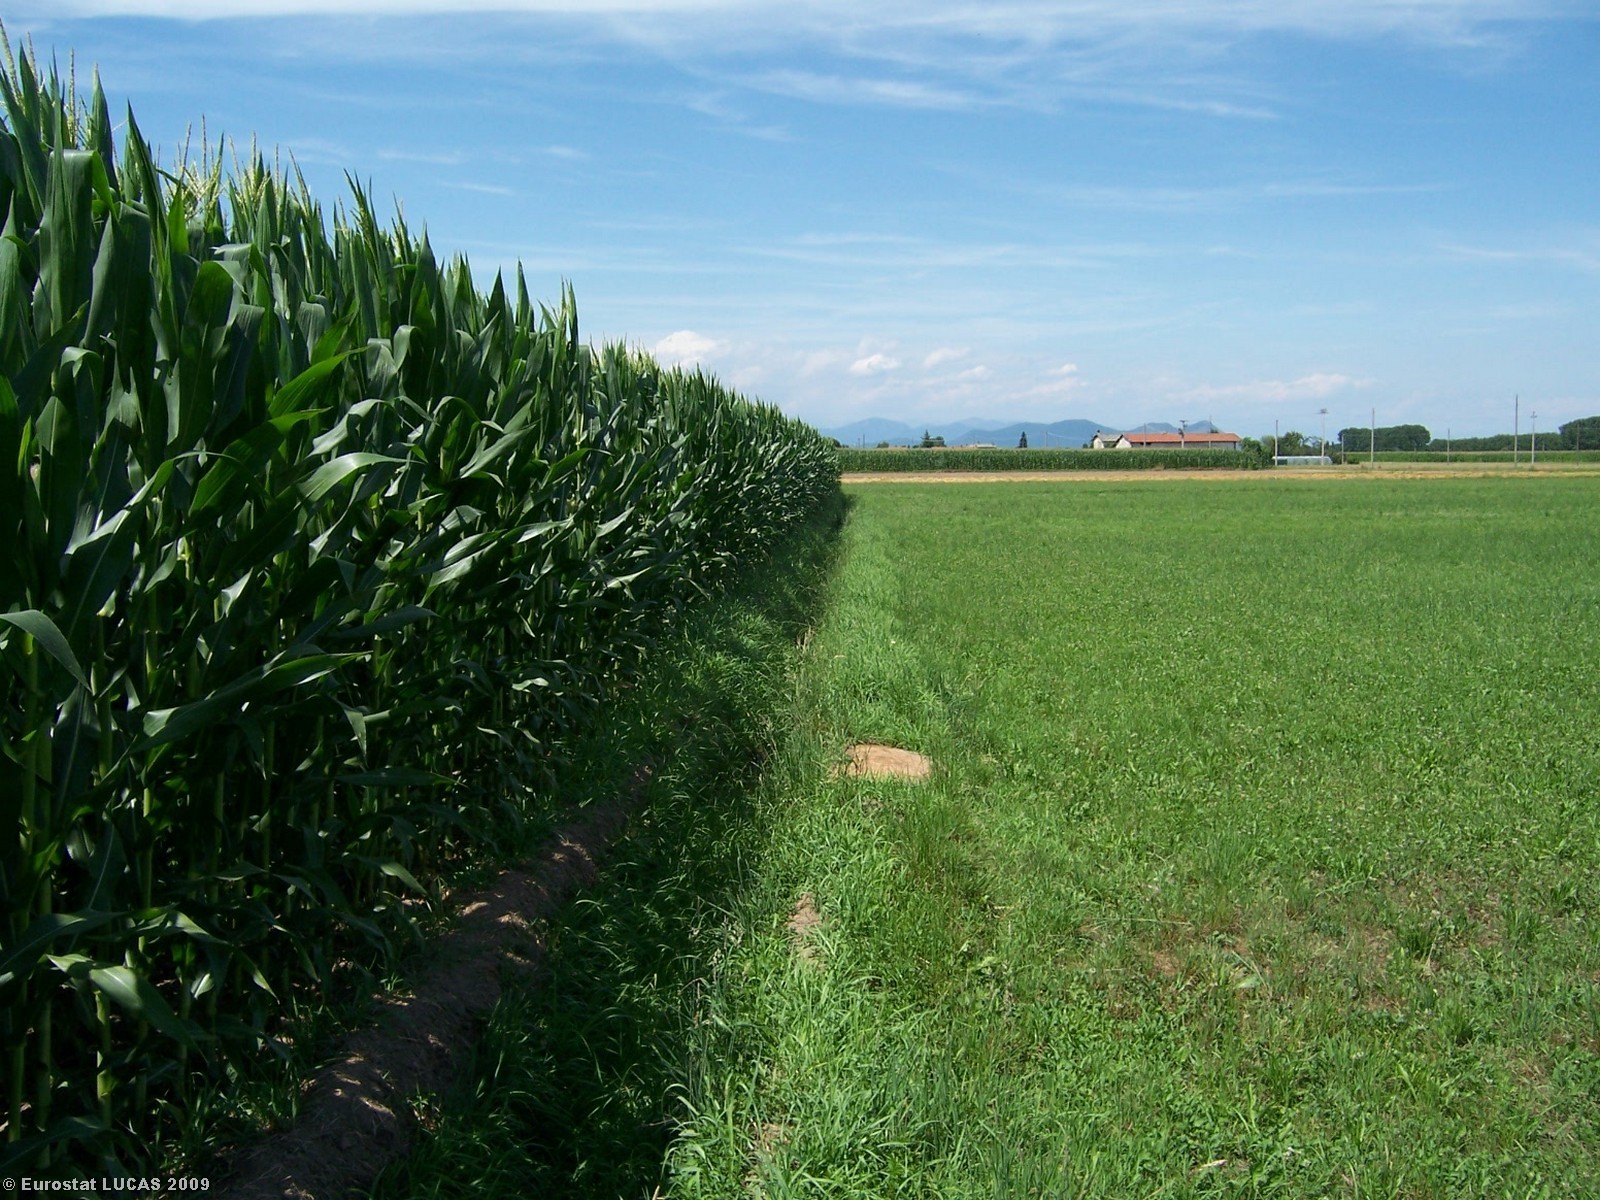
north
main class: Cropland
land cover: Maize
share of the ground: > 75 %
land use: Agriculture (excluding fallow land and kitchen gardens)
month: July
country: IT
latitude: 44.8048
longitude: 7.3877
